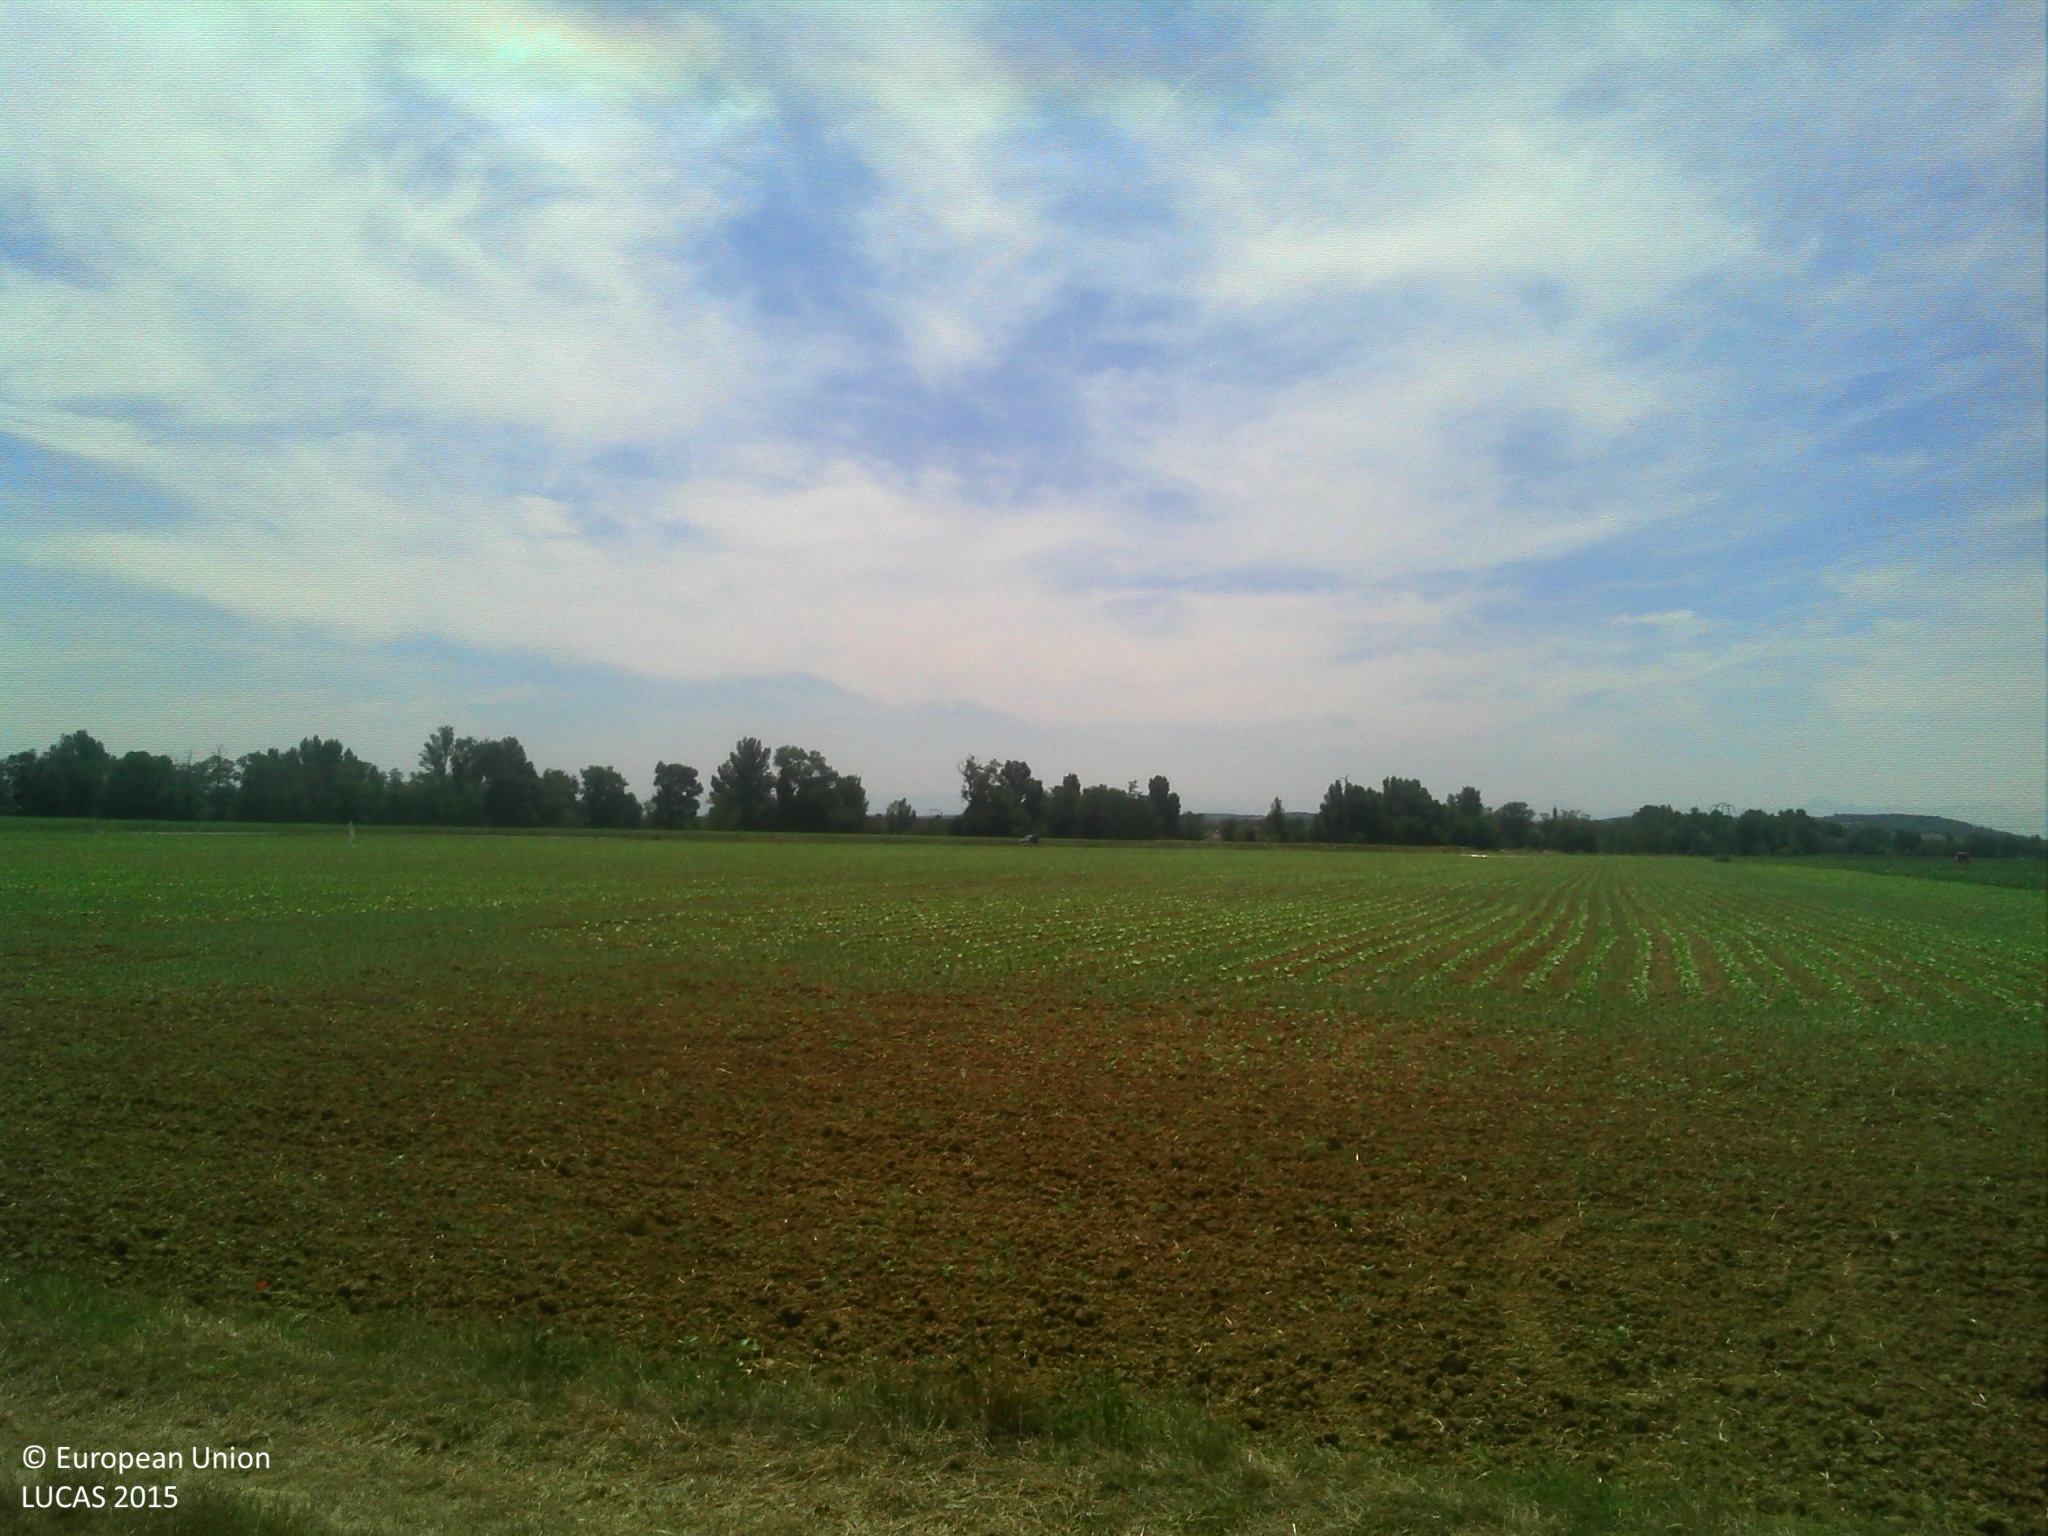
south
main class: Cropland
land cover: Common wheat
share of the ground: > 75 %
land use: Agriculture (excluding fallow land and kitchen gardens)
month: July
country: FR
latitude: 43.4303
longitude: 1.3931
